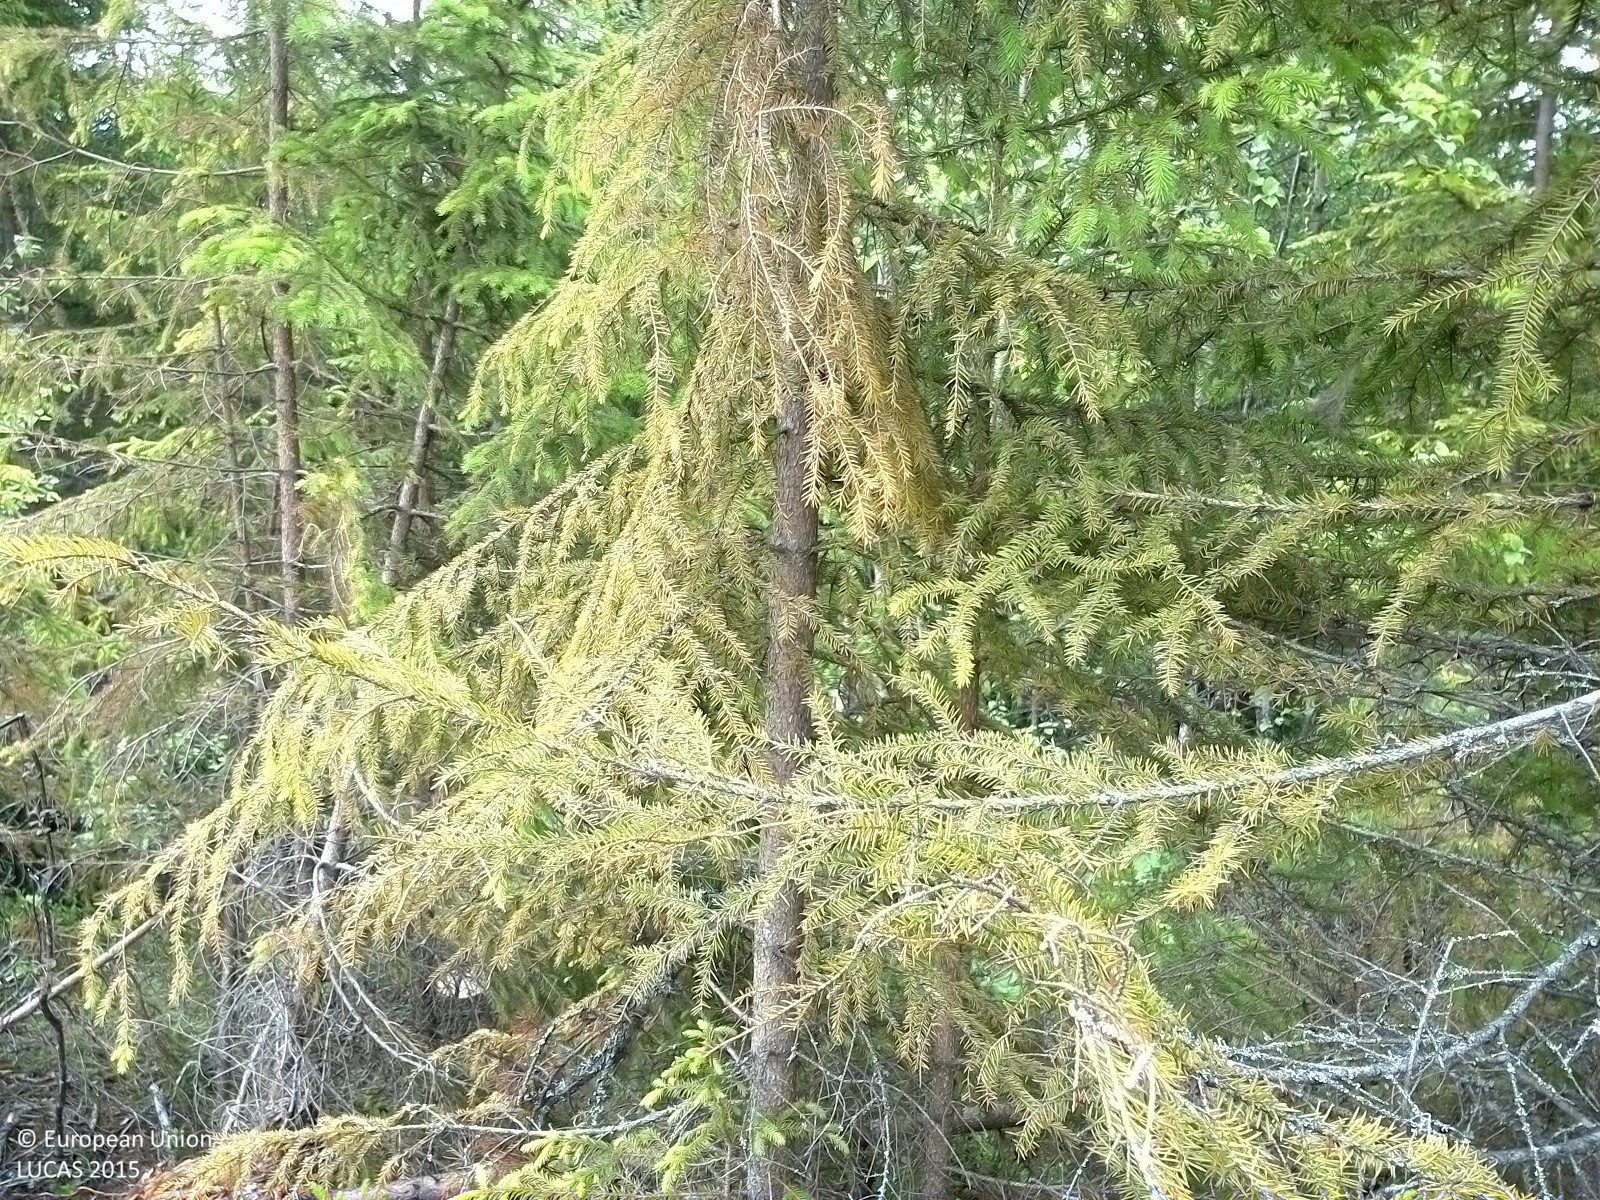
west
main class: Woodland
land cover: Other coniferous woodland
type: boreal forest
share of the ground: 10 - 25 %
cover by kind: coniferous forest trees 25 %, herbaceous plants 25 %
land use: Forestry
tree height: < 5 m
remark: Clear cut
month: June
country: SE
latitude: 62.0263
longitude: 16.3452
